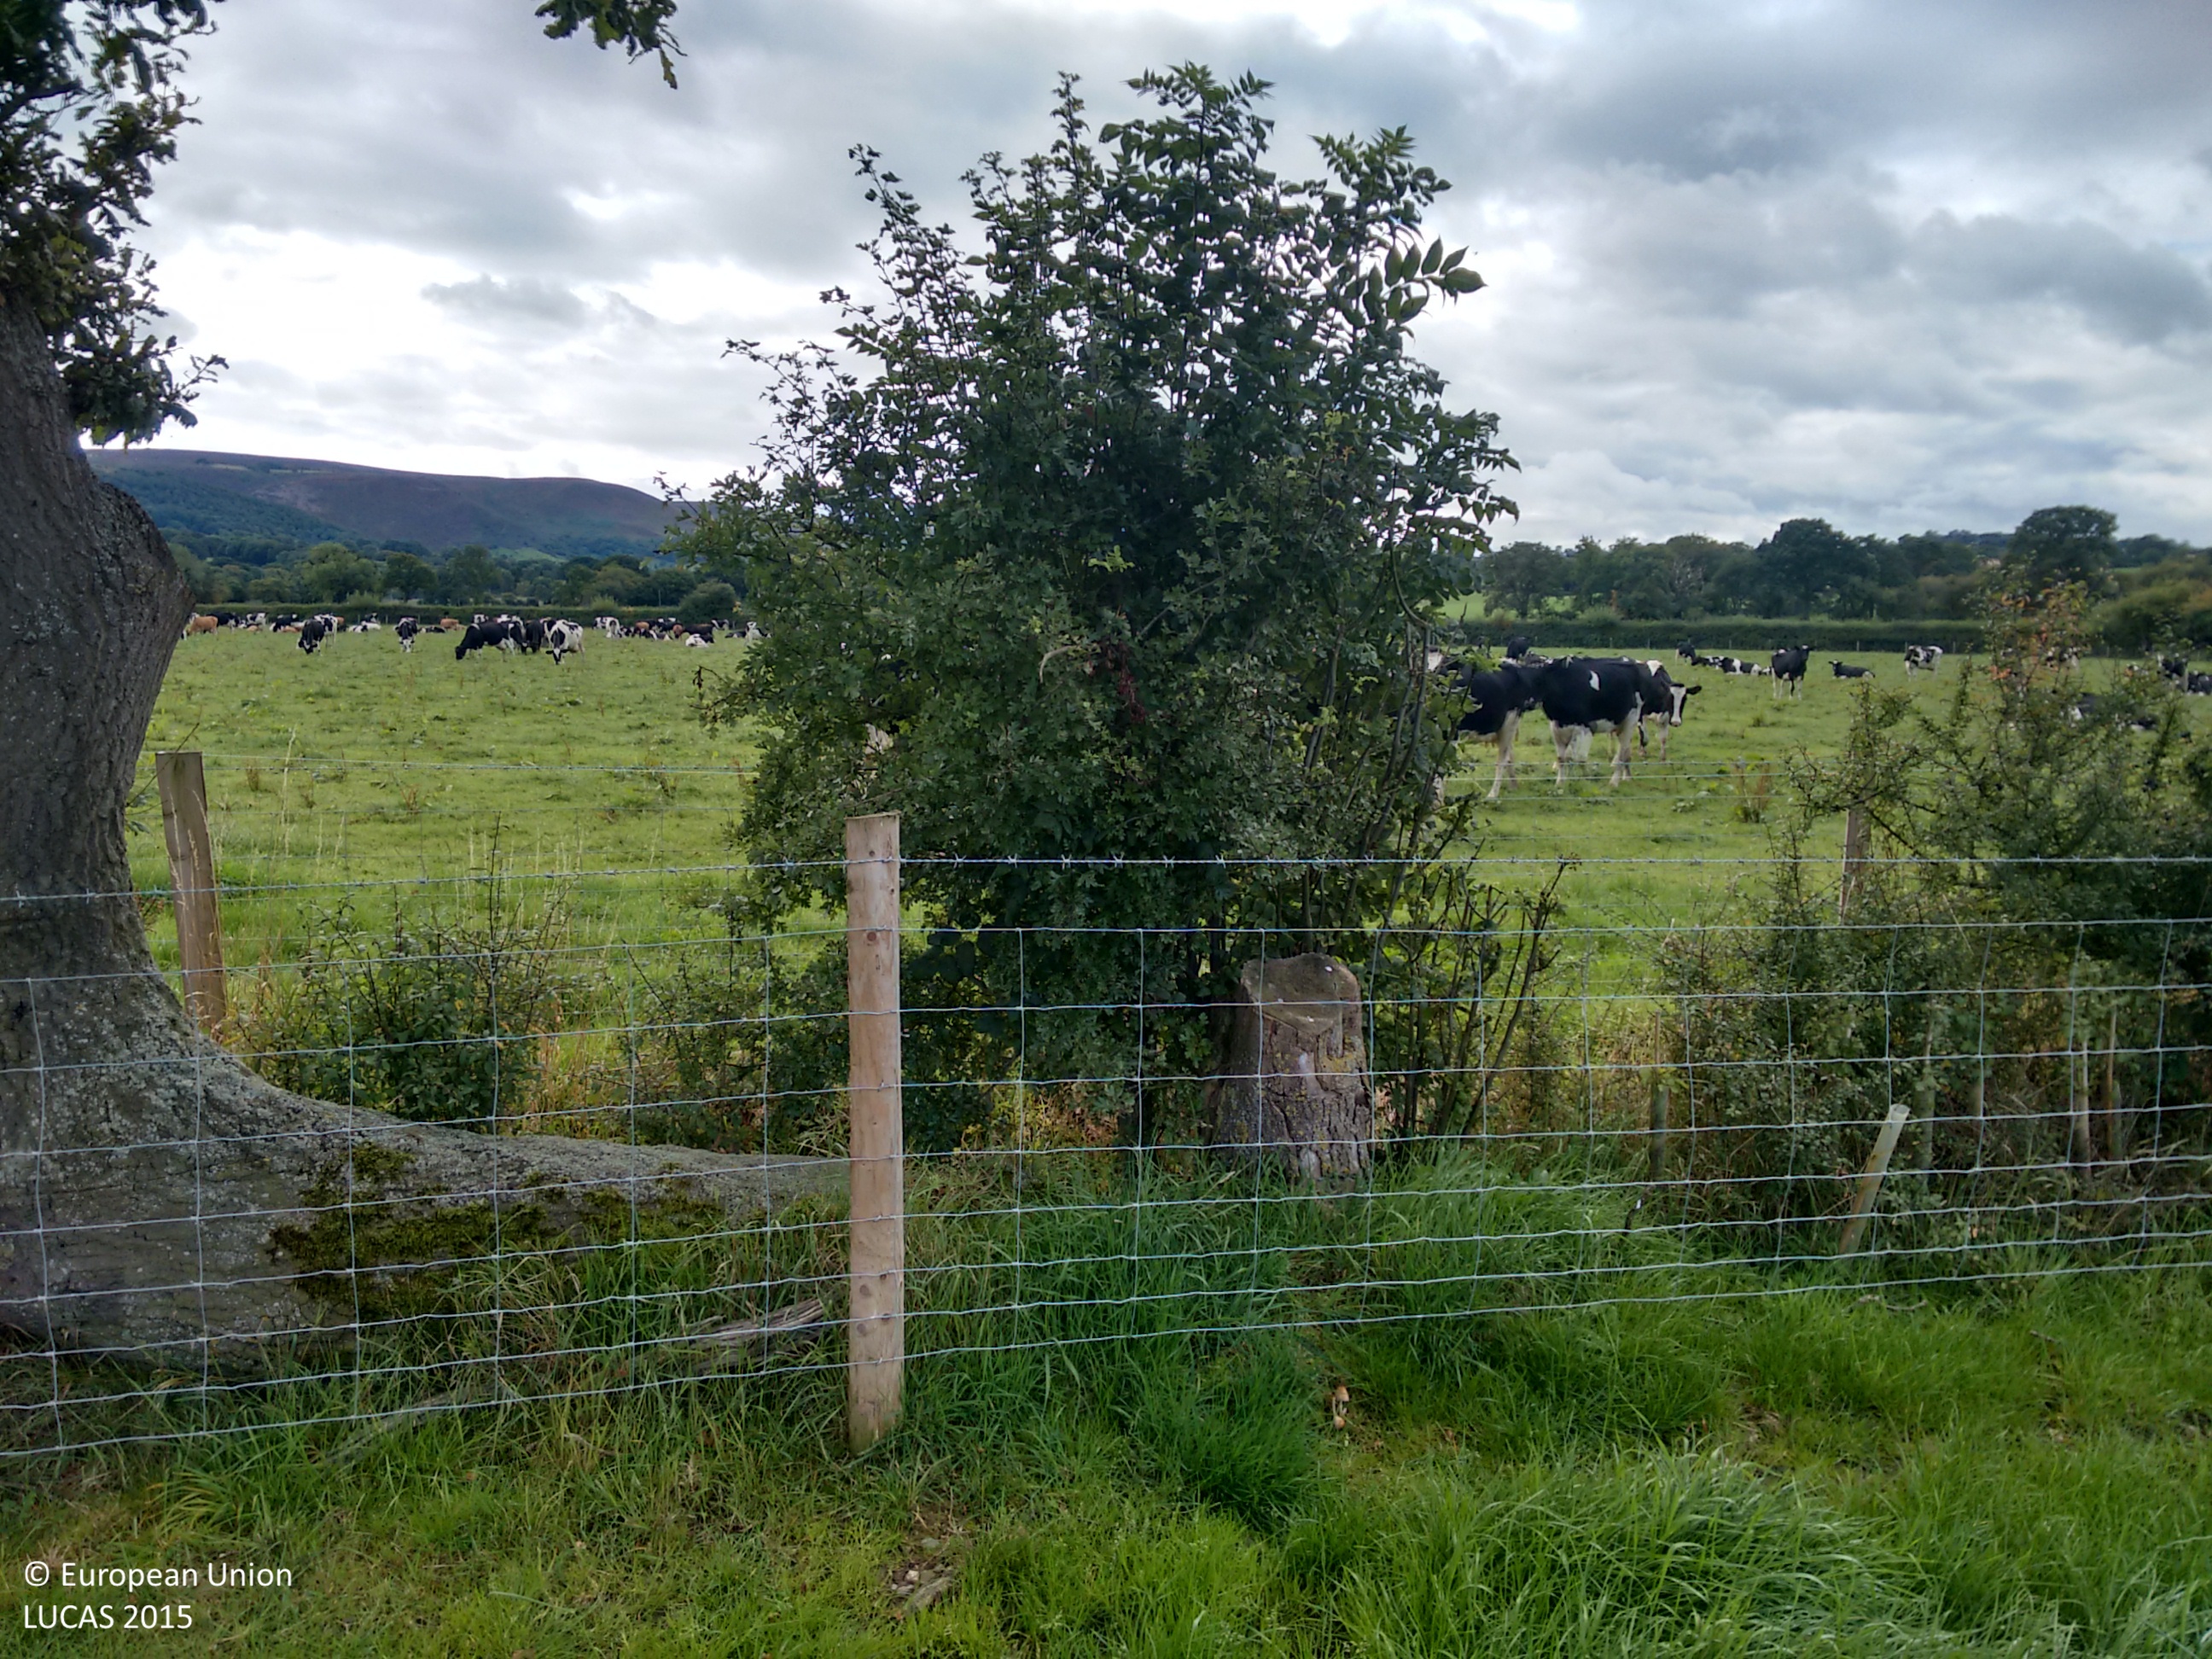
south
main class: Grassland
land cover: Grassland without tree/shrub cover
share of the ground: > 75 %
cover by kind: herbaceous plants 100 %
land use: Agriculture (excluding fallow land and kitchen gardens)
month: September
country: GB
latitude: 52.6307
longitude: -2.9426
